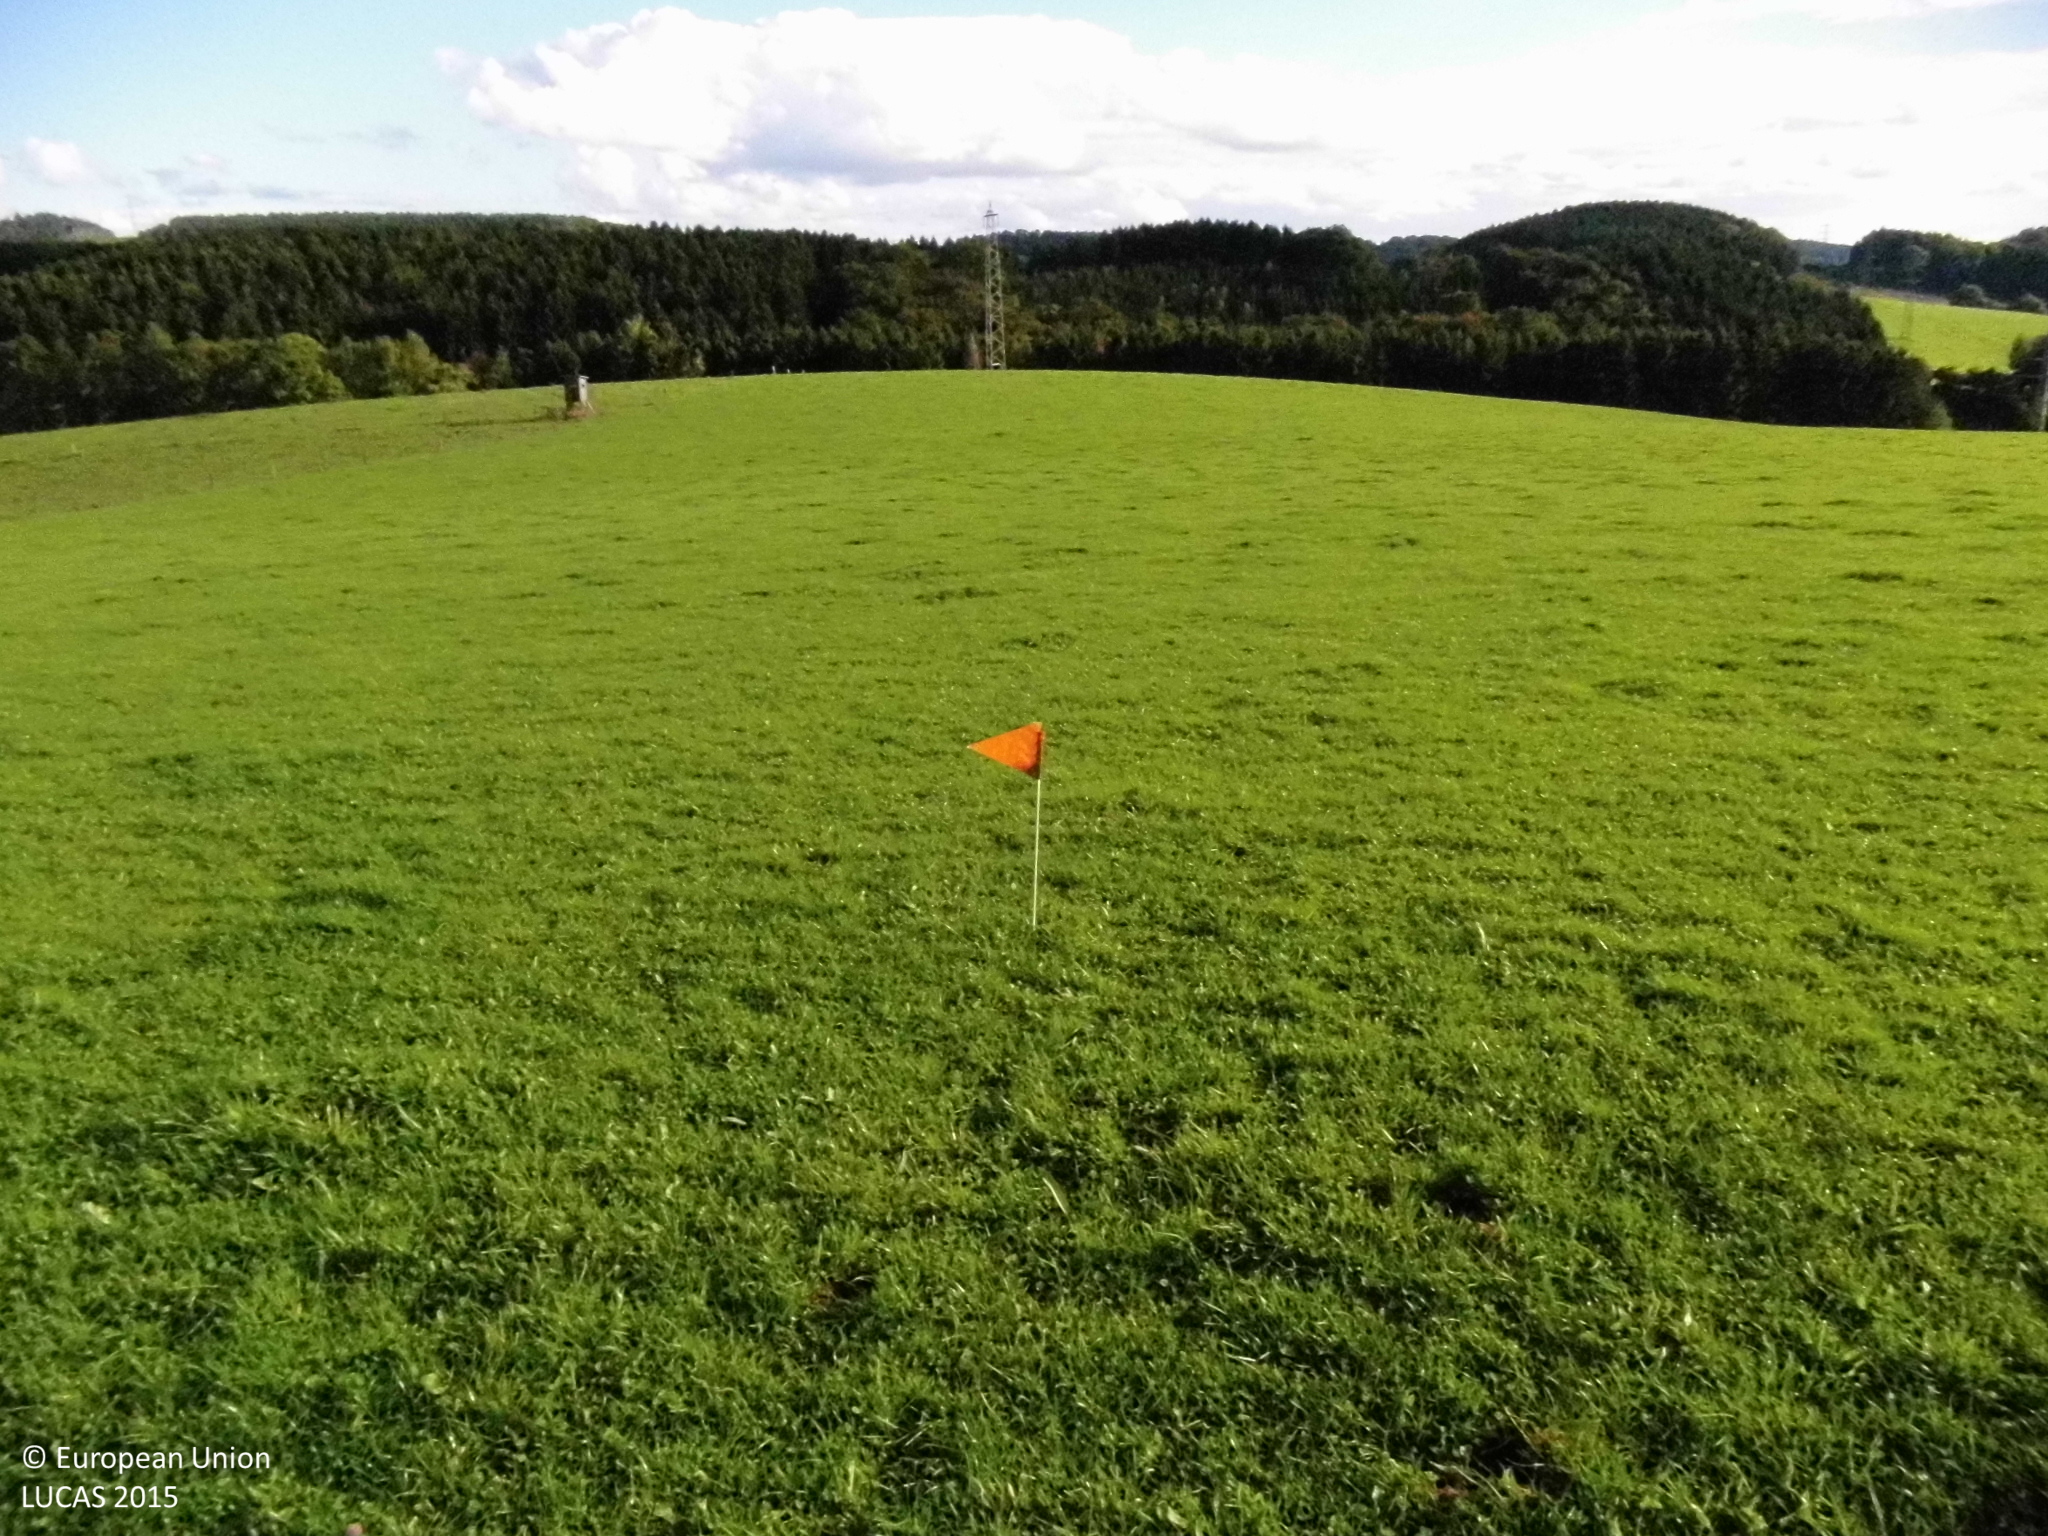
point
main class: Grassland
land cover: Grassland without tree/shrub cover
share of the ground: > 75 %
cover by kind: herbaceous plants 100 %
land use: Agriculture (excluding fallow land and kitchen gardens)
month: September
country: DE
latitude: 51.0551
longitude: 7.4465
